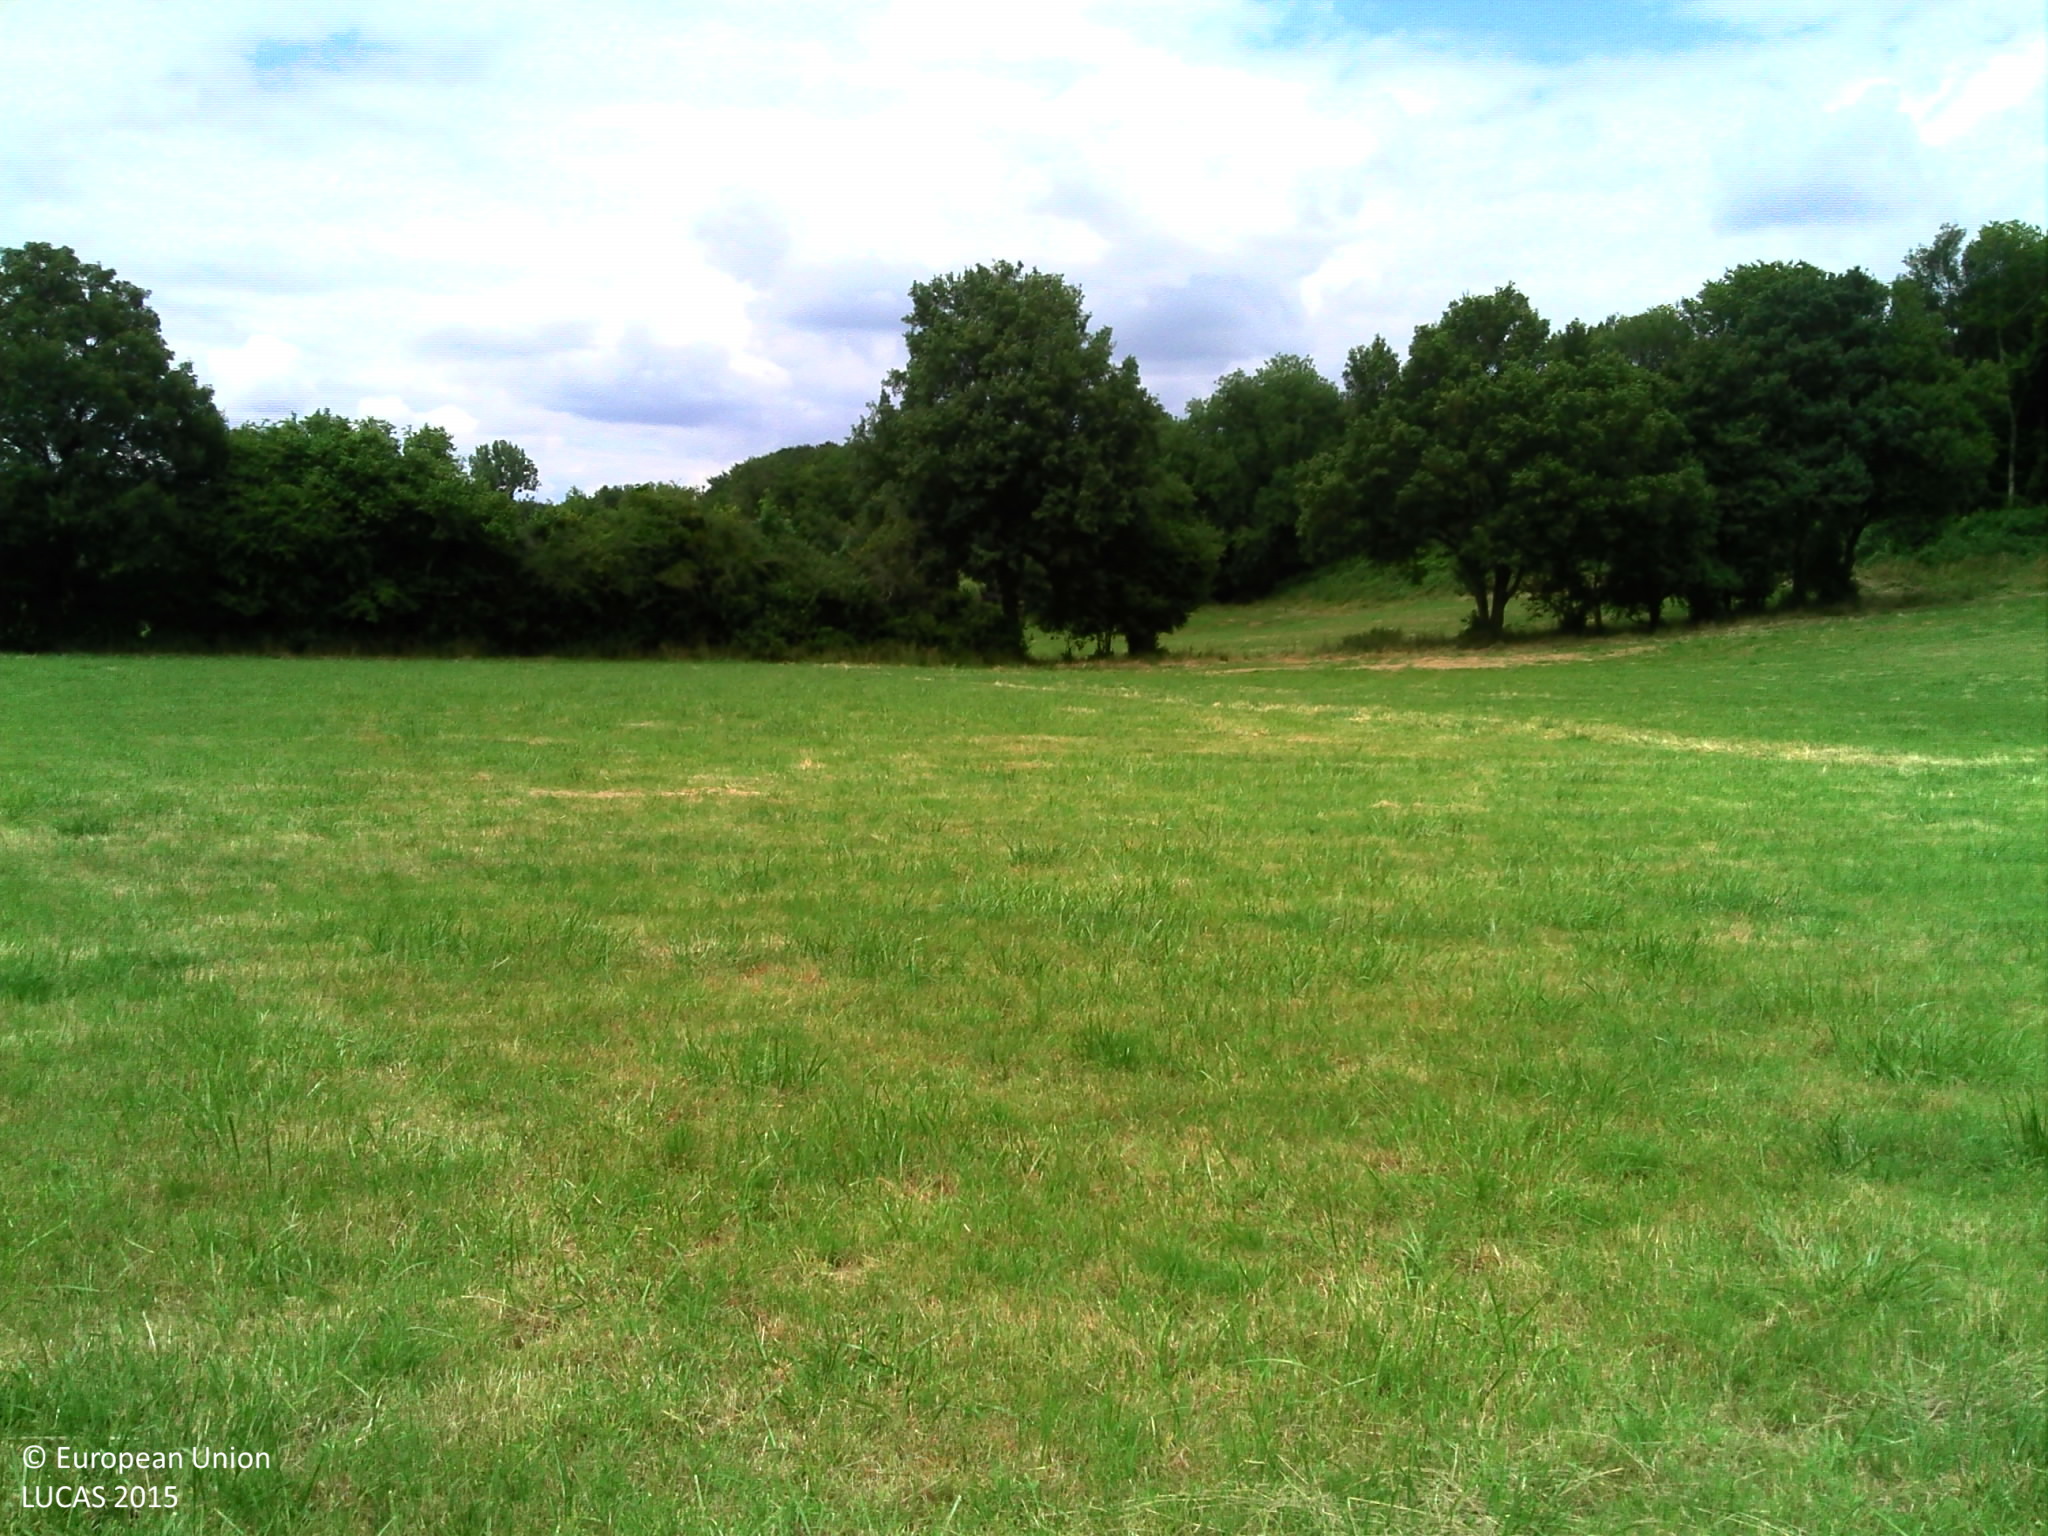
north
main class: Grassland
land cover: Grassland without tree/shrub cover
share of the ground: > 75 %
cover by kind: herbaceous plants 100 %
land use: Agriculture (excluding fallow land and kitchen gardens)
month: June
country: FR
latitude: 47.3277
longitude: 3.2075
